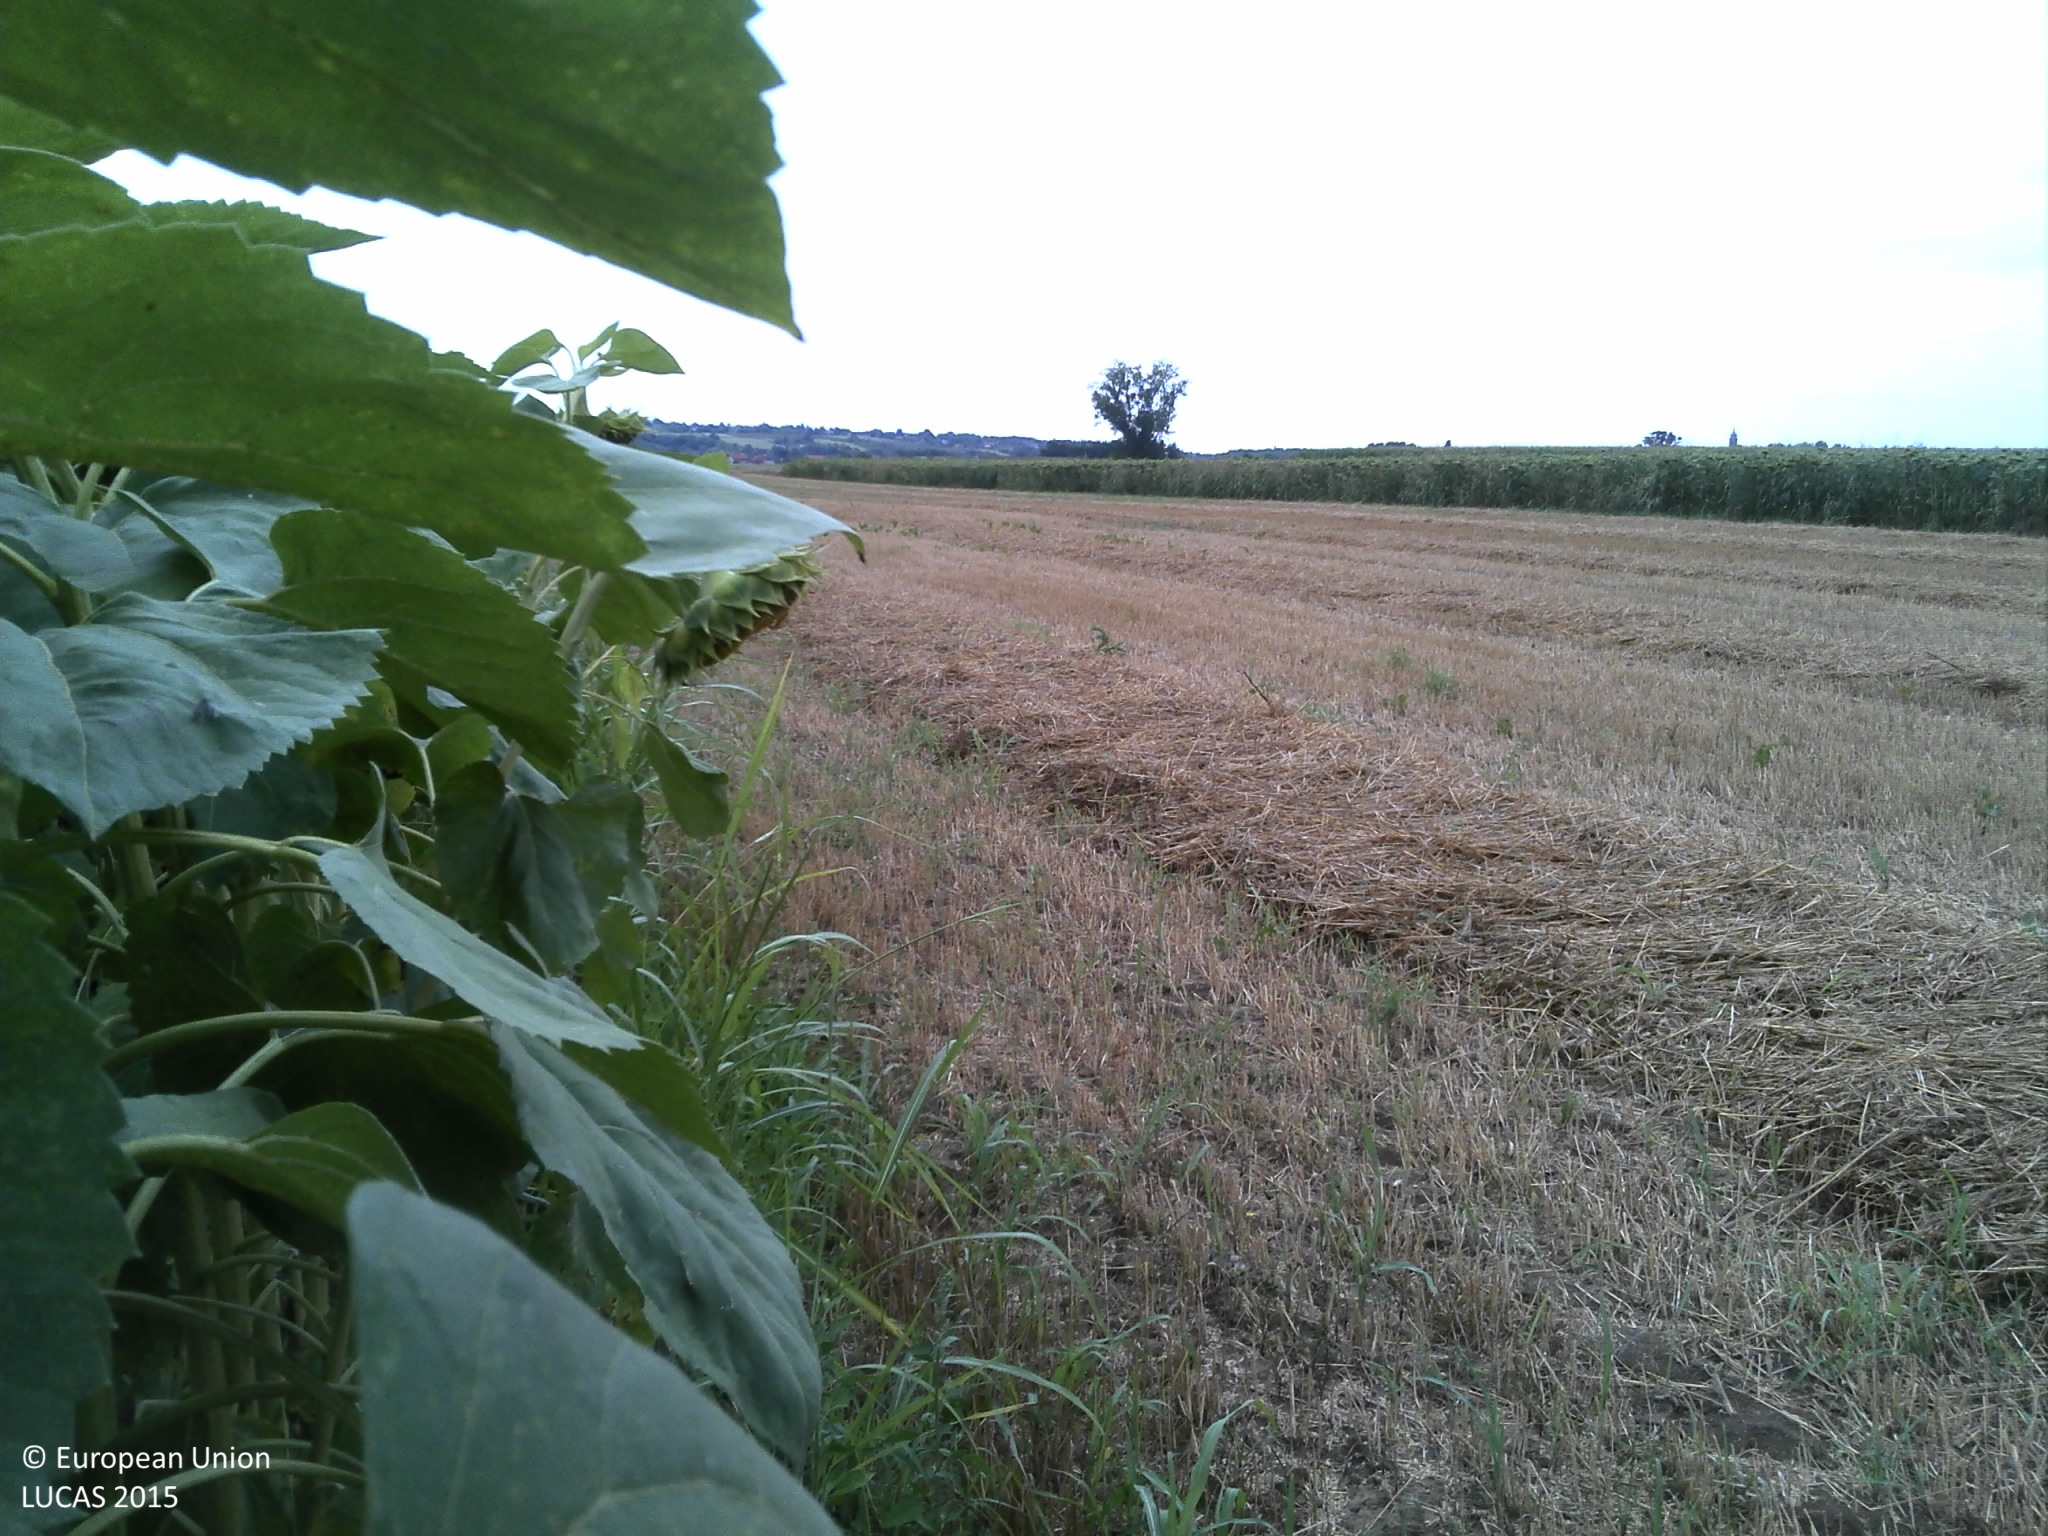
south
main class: Cropland
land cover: Sunflower
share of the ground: 25 - 50 %
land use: Agriculture (excluding fallow land and kitchen gardens)
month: July
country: HR
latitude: 45.8038
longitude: 18.6164
